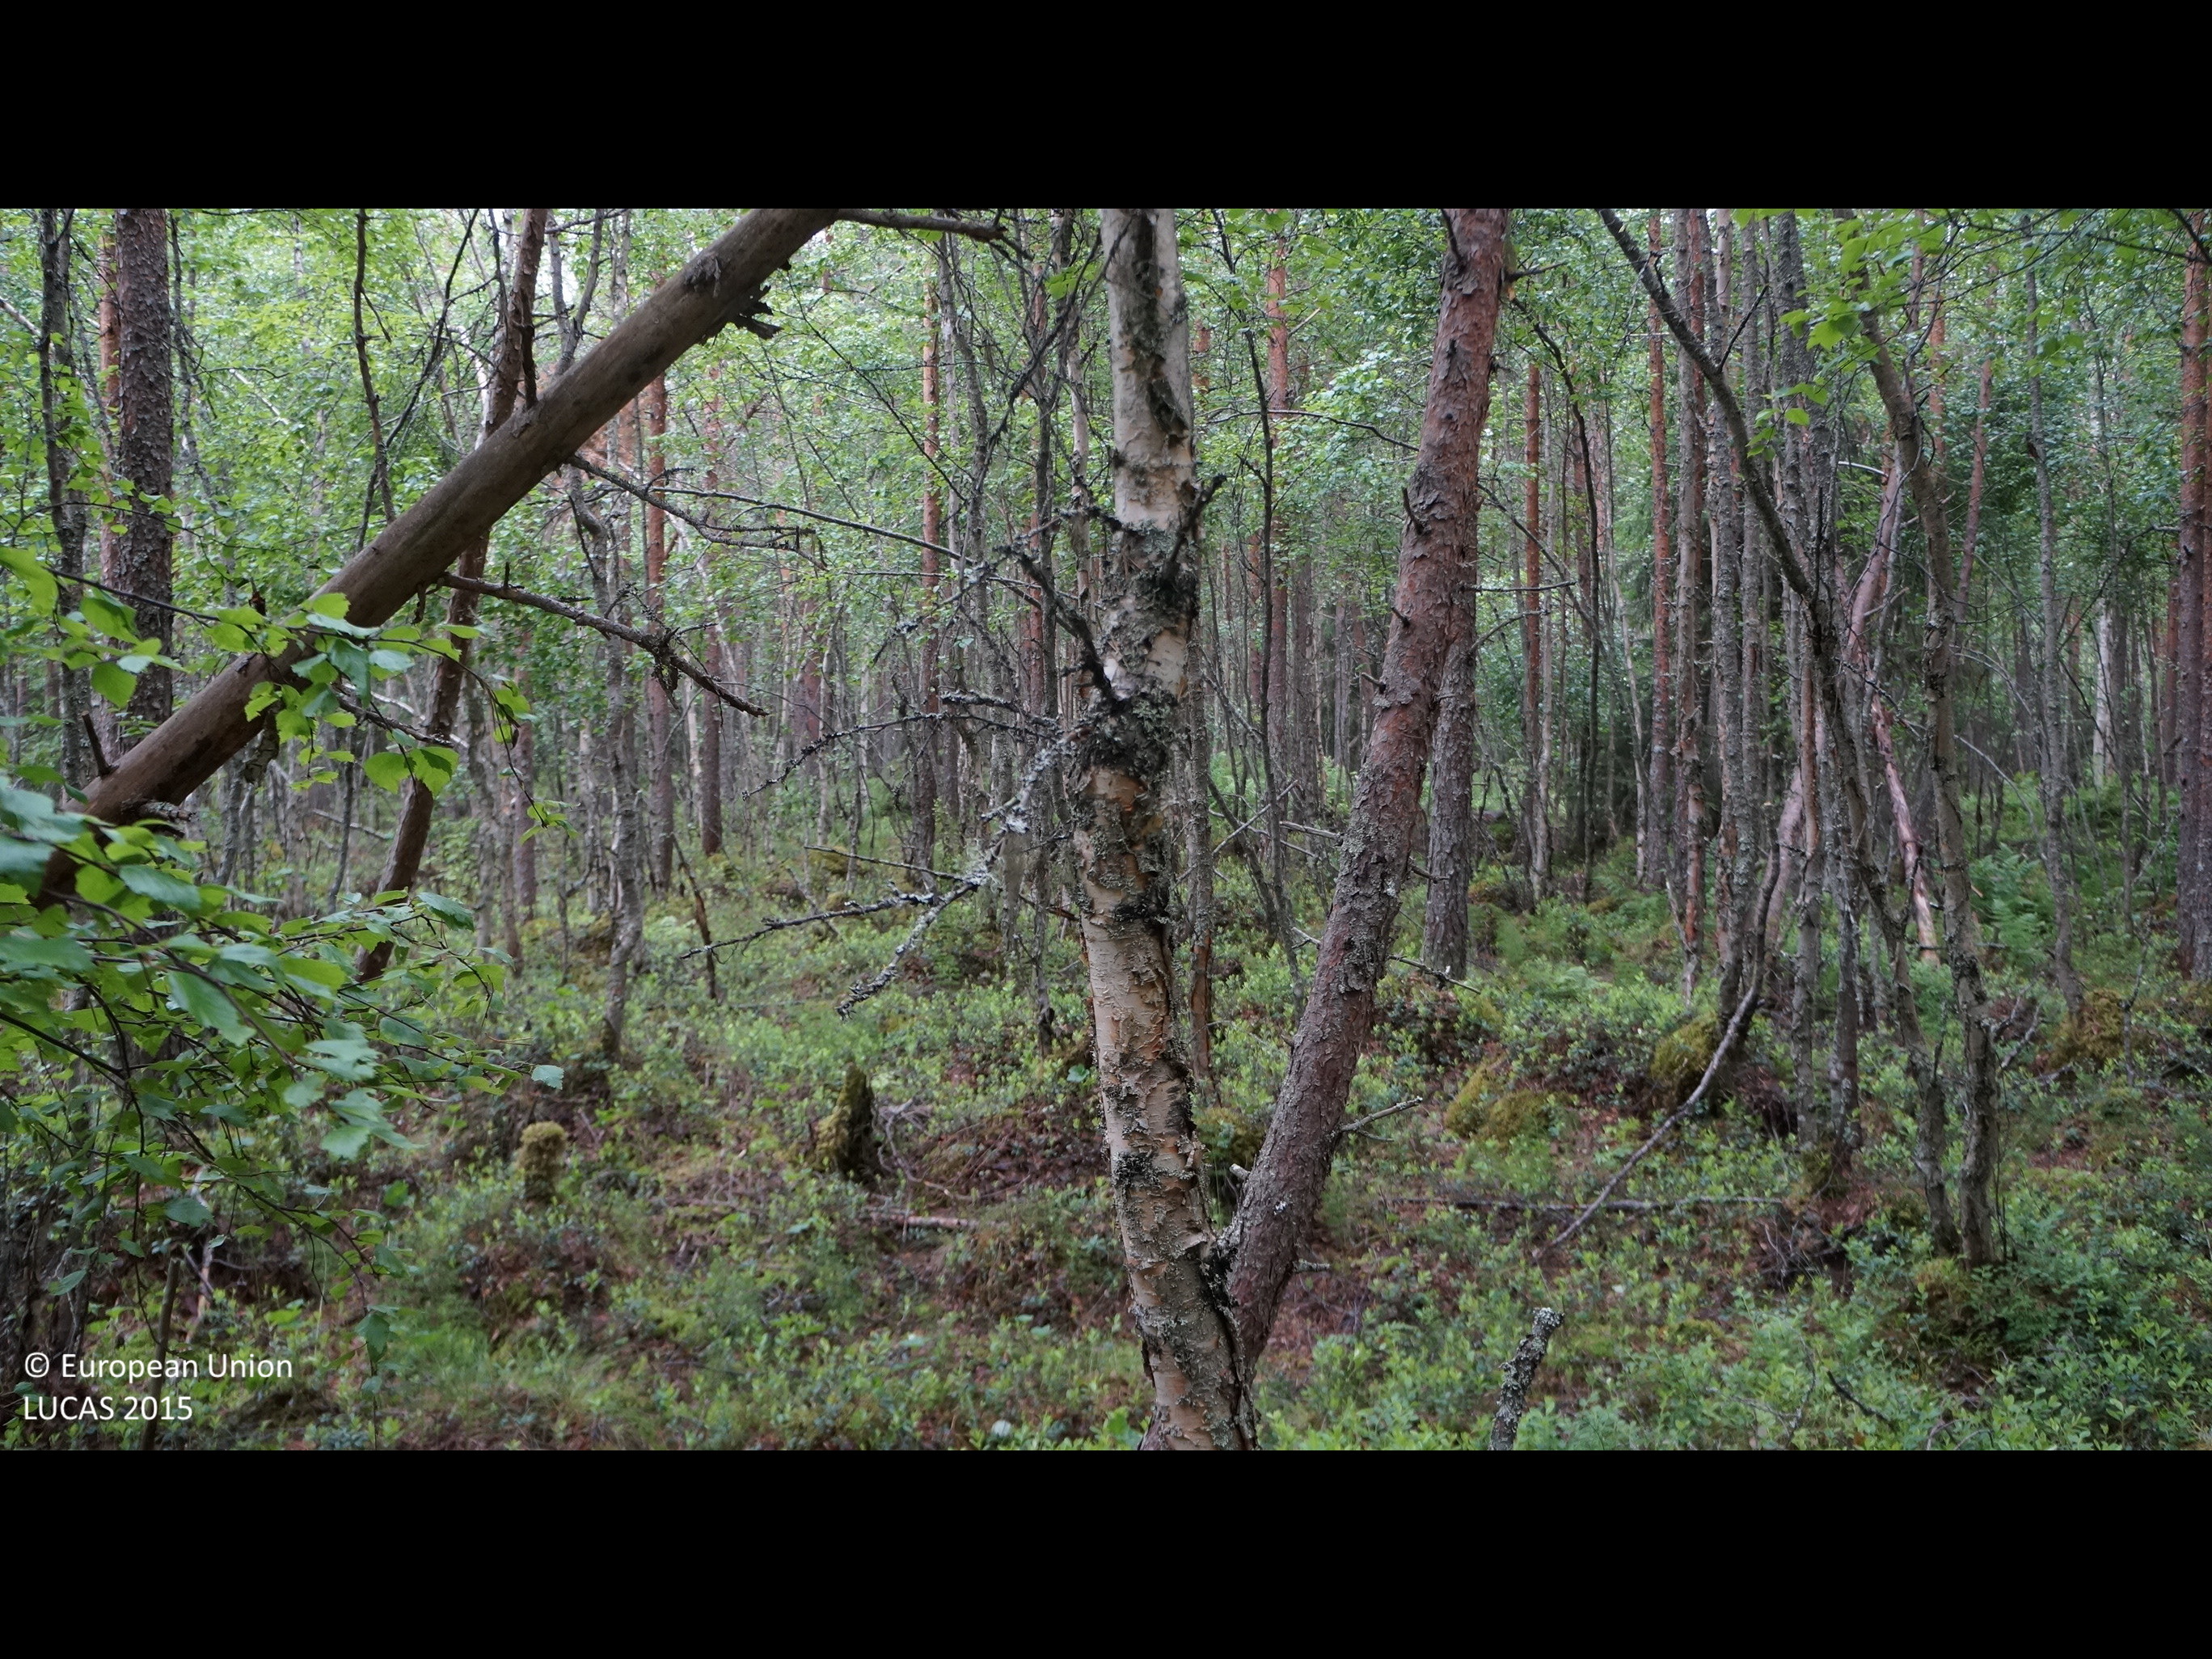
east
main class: Woodland
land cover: Pine dominated mixed woodland
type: boreal forest
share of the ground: > 75 %
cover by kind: coniferous forest trees 45 %, broadleaved forest trees 30 %, shrubs 15 %, lichens and mosses 10 %
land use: Forestry
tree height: > 5 m
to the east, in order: Pine dominated mixed woodland; Ditches and canals; Pine dominated mixed woodland; Ditches and canals; Pine dominated mixed woodland; Pine dominated coniferous woodland; Pine dominated mixed woodland; Ditches and canals; Pine dominated coniferous woodland; Pine dominated mixed woodland; Pine dominated coniferous woodland
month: June
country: FI
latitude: 64.3035
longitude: 24.6467
